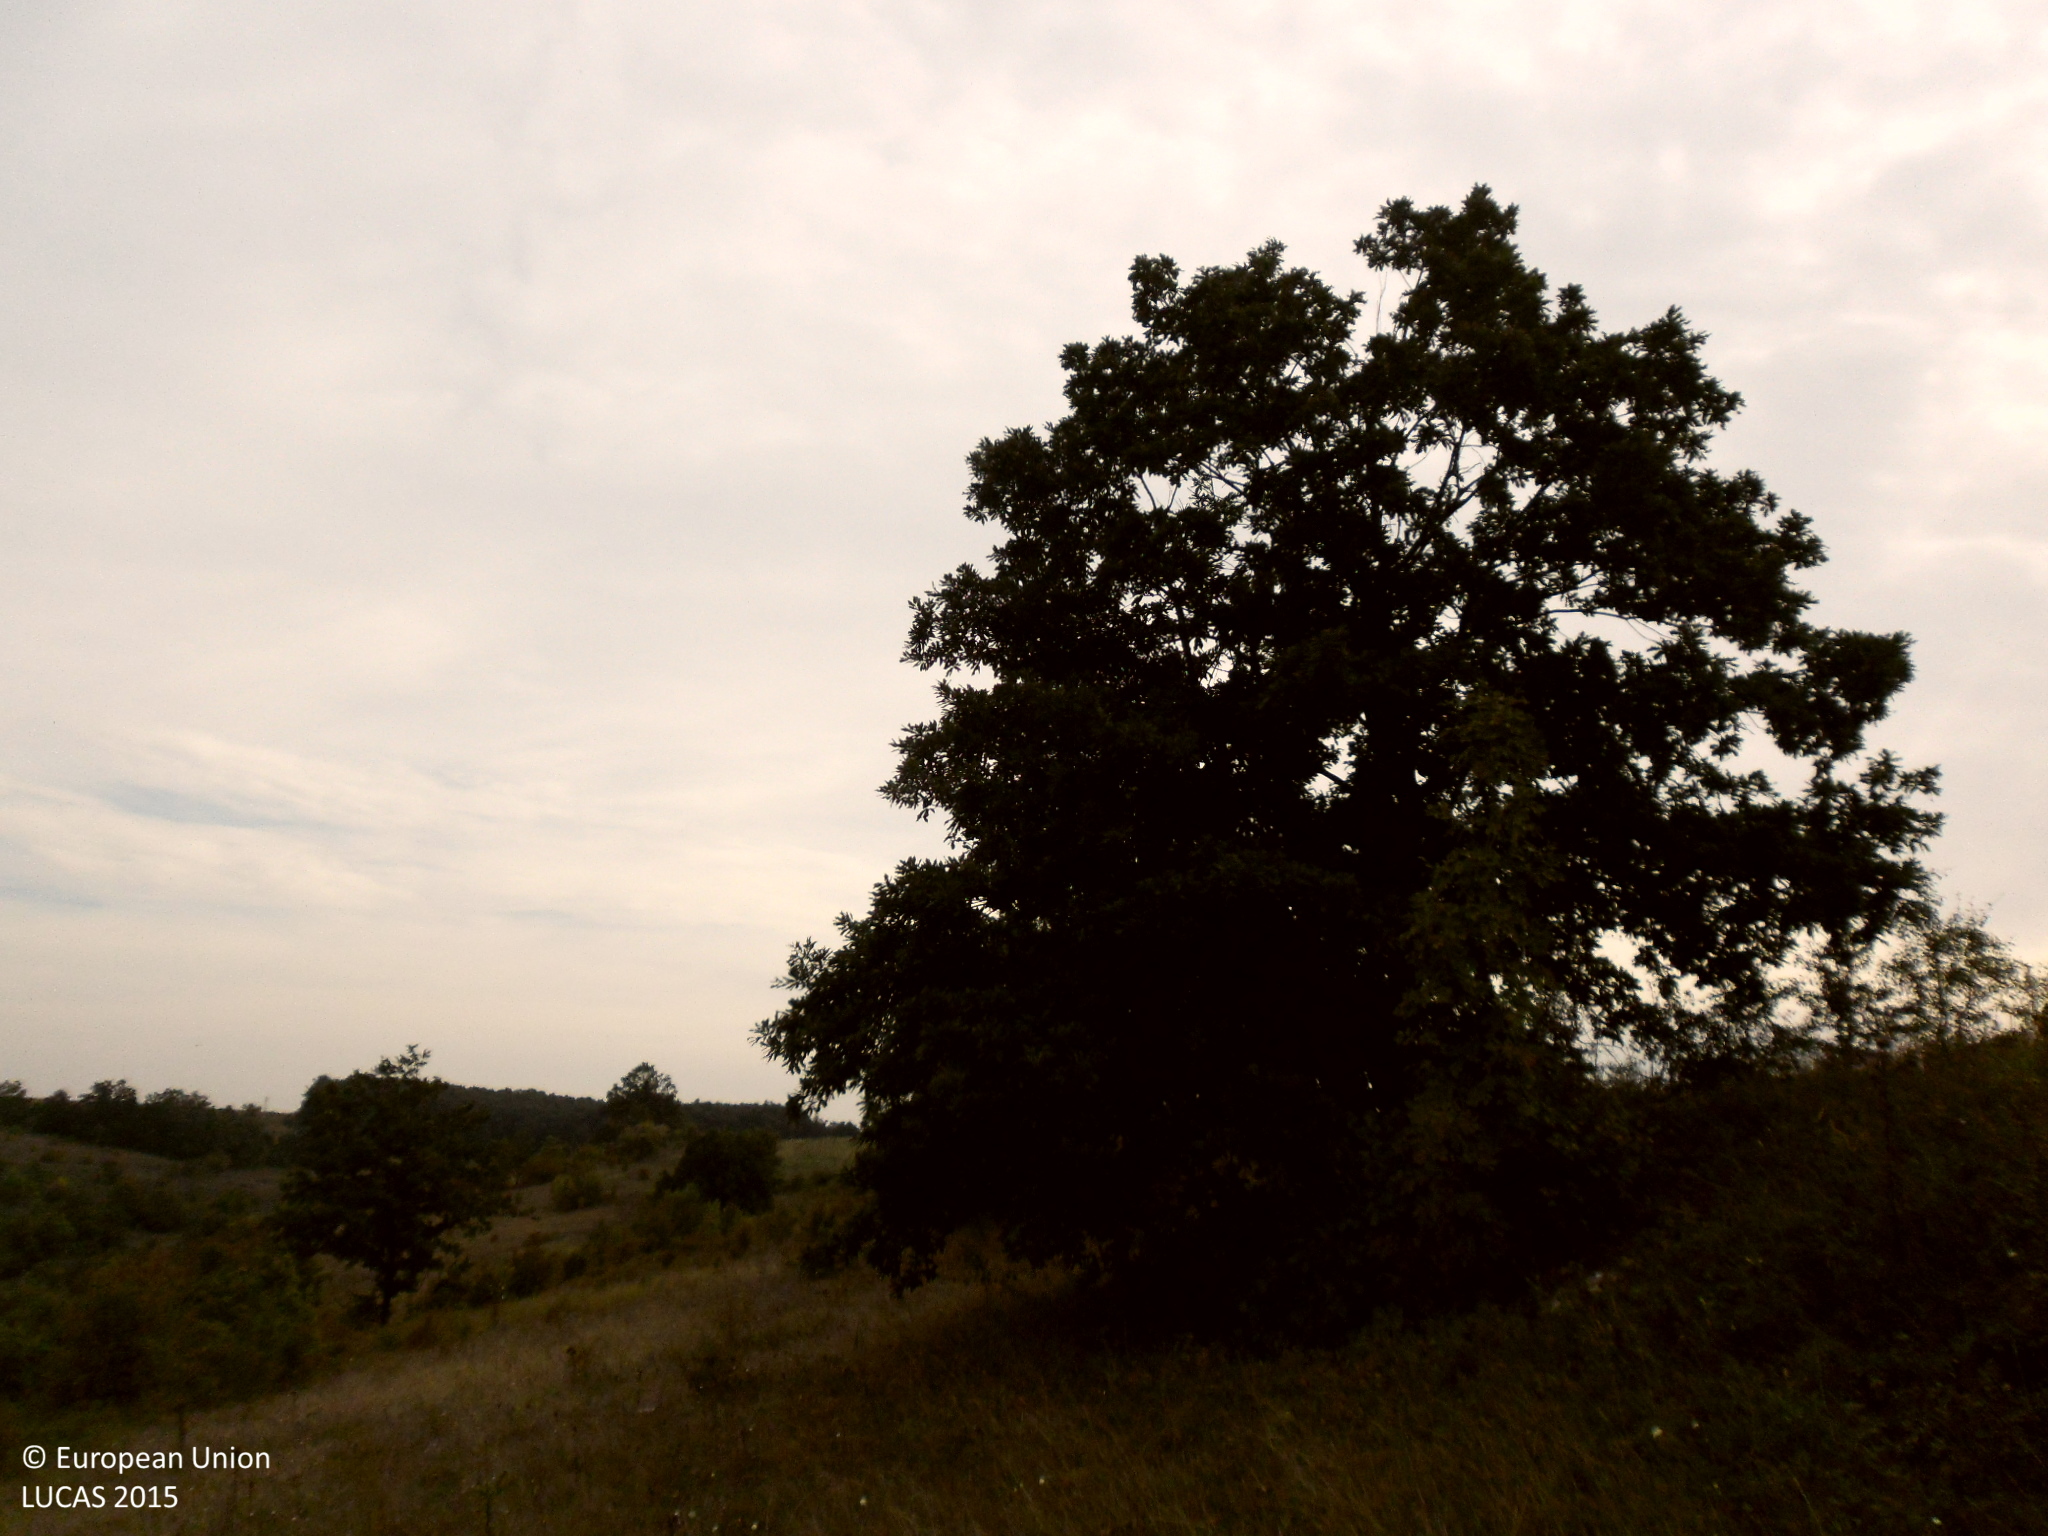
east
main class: Grassland
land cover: Grassland with sparse tree/shrub cover
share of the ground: > 75 %
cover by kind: herbaceous plants 90 %, broadleaved forest trees 5 %, shrubs 5 %
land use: Semi-natural and natural areas not in use
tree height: > 5 m
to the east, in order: Grassland with sparse tree/shrub cover; Abandoned hedges; Spontaneously vegetated surfaces
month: October
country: BG
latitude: 43.9963
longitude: 22.6184
